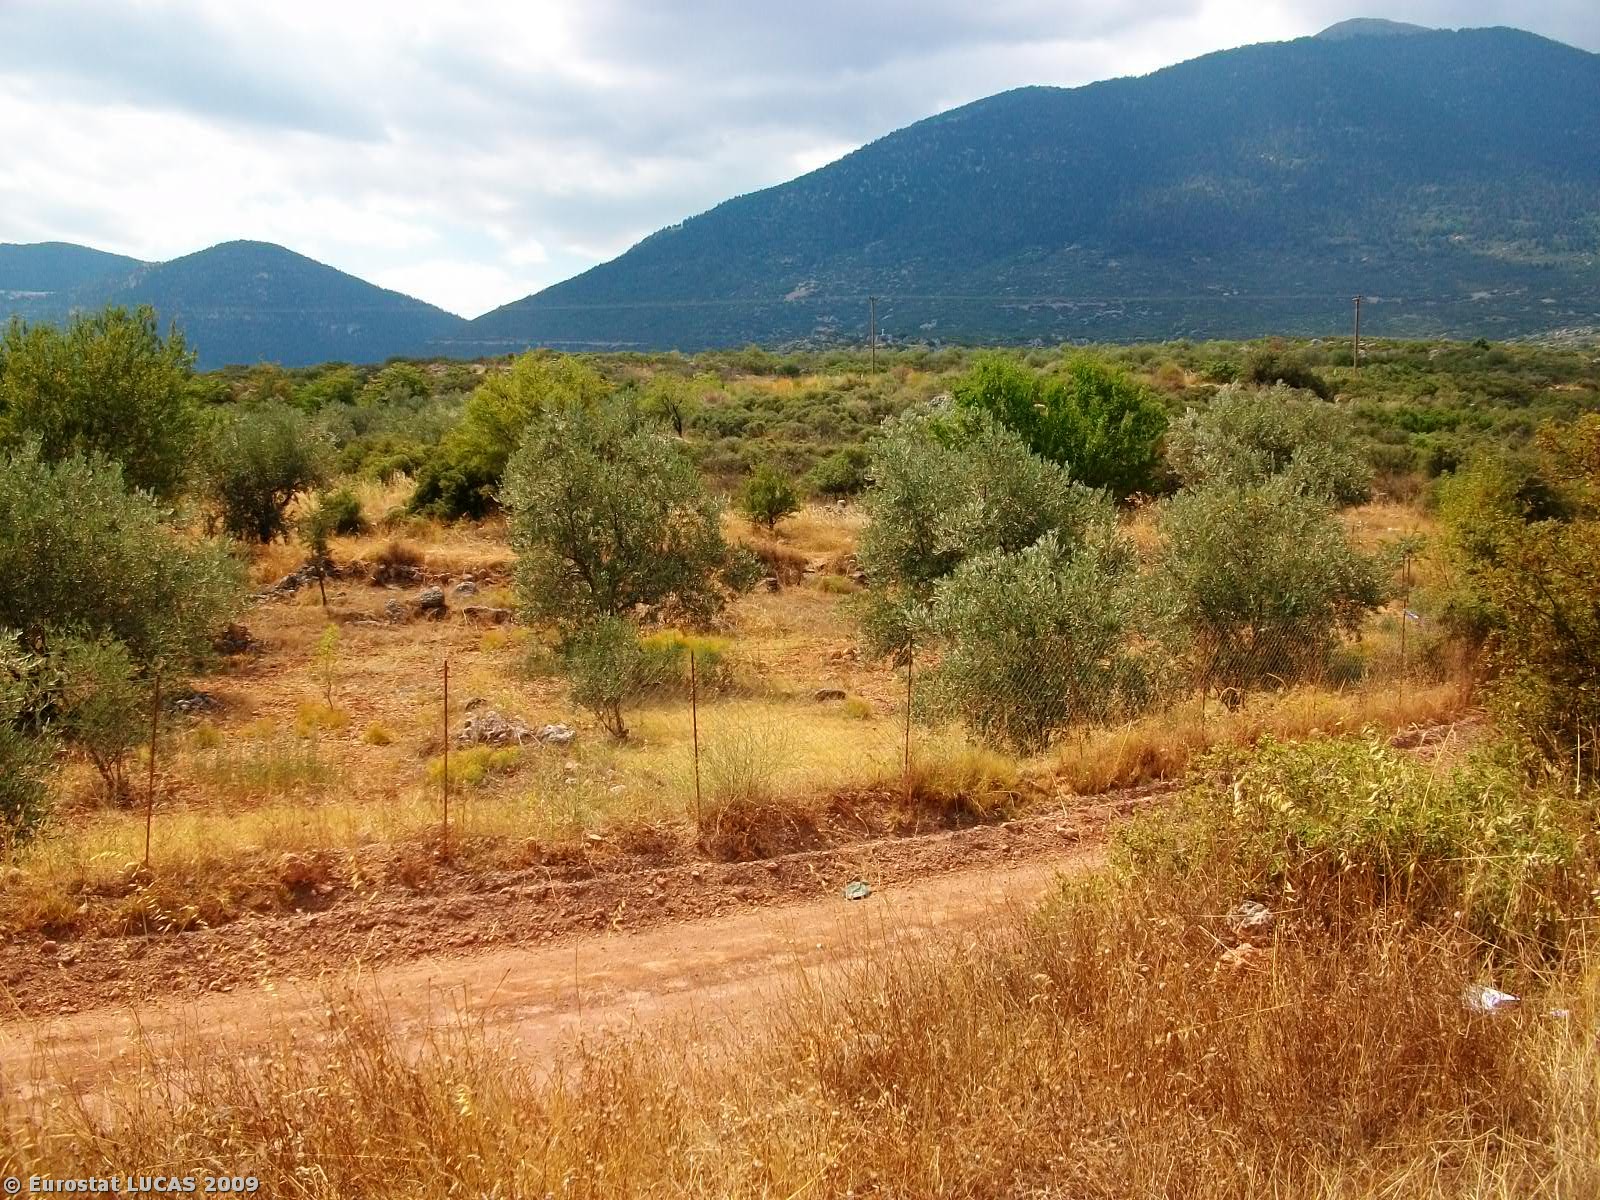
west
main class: Grassland
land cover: Grassland with sparse tree/shrub cover
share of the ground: > 75 %
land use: Agriculture (excluding fallow land and kitchen gardens)
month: August
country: GR
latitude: 38.4935
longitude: 22.3690
